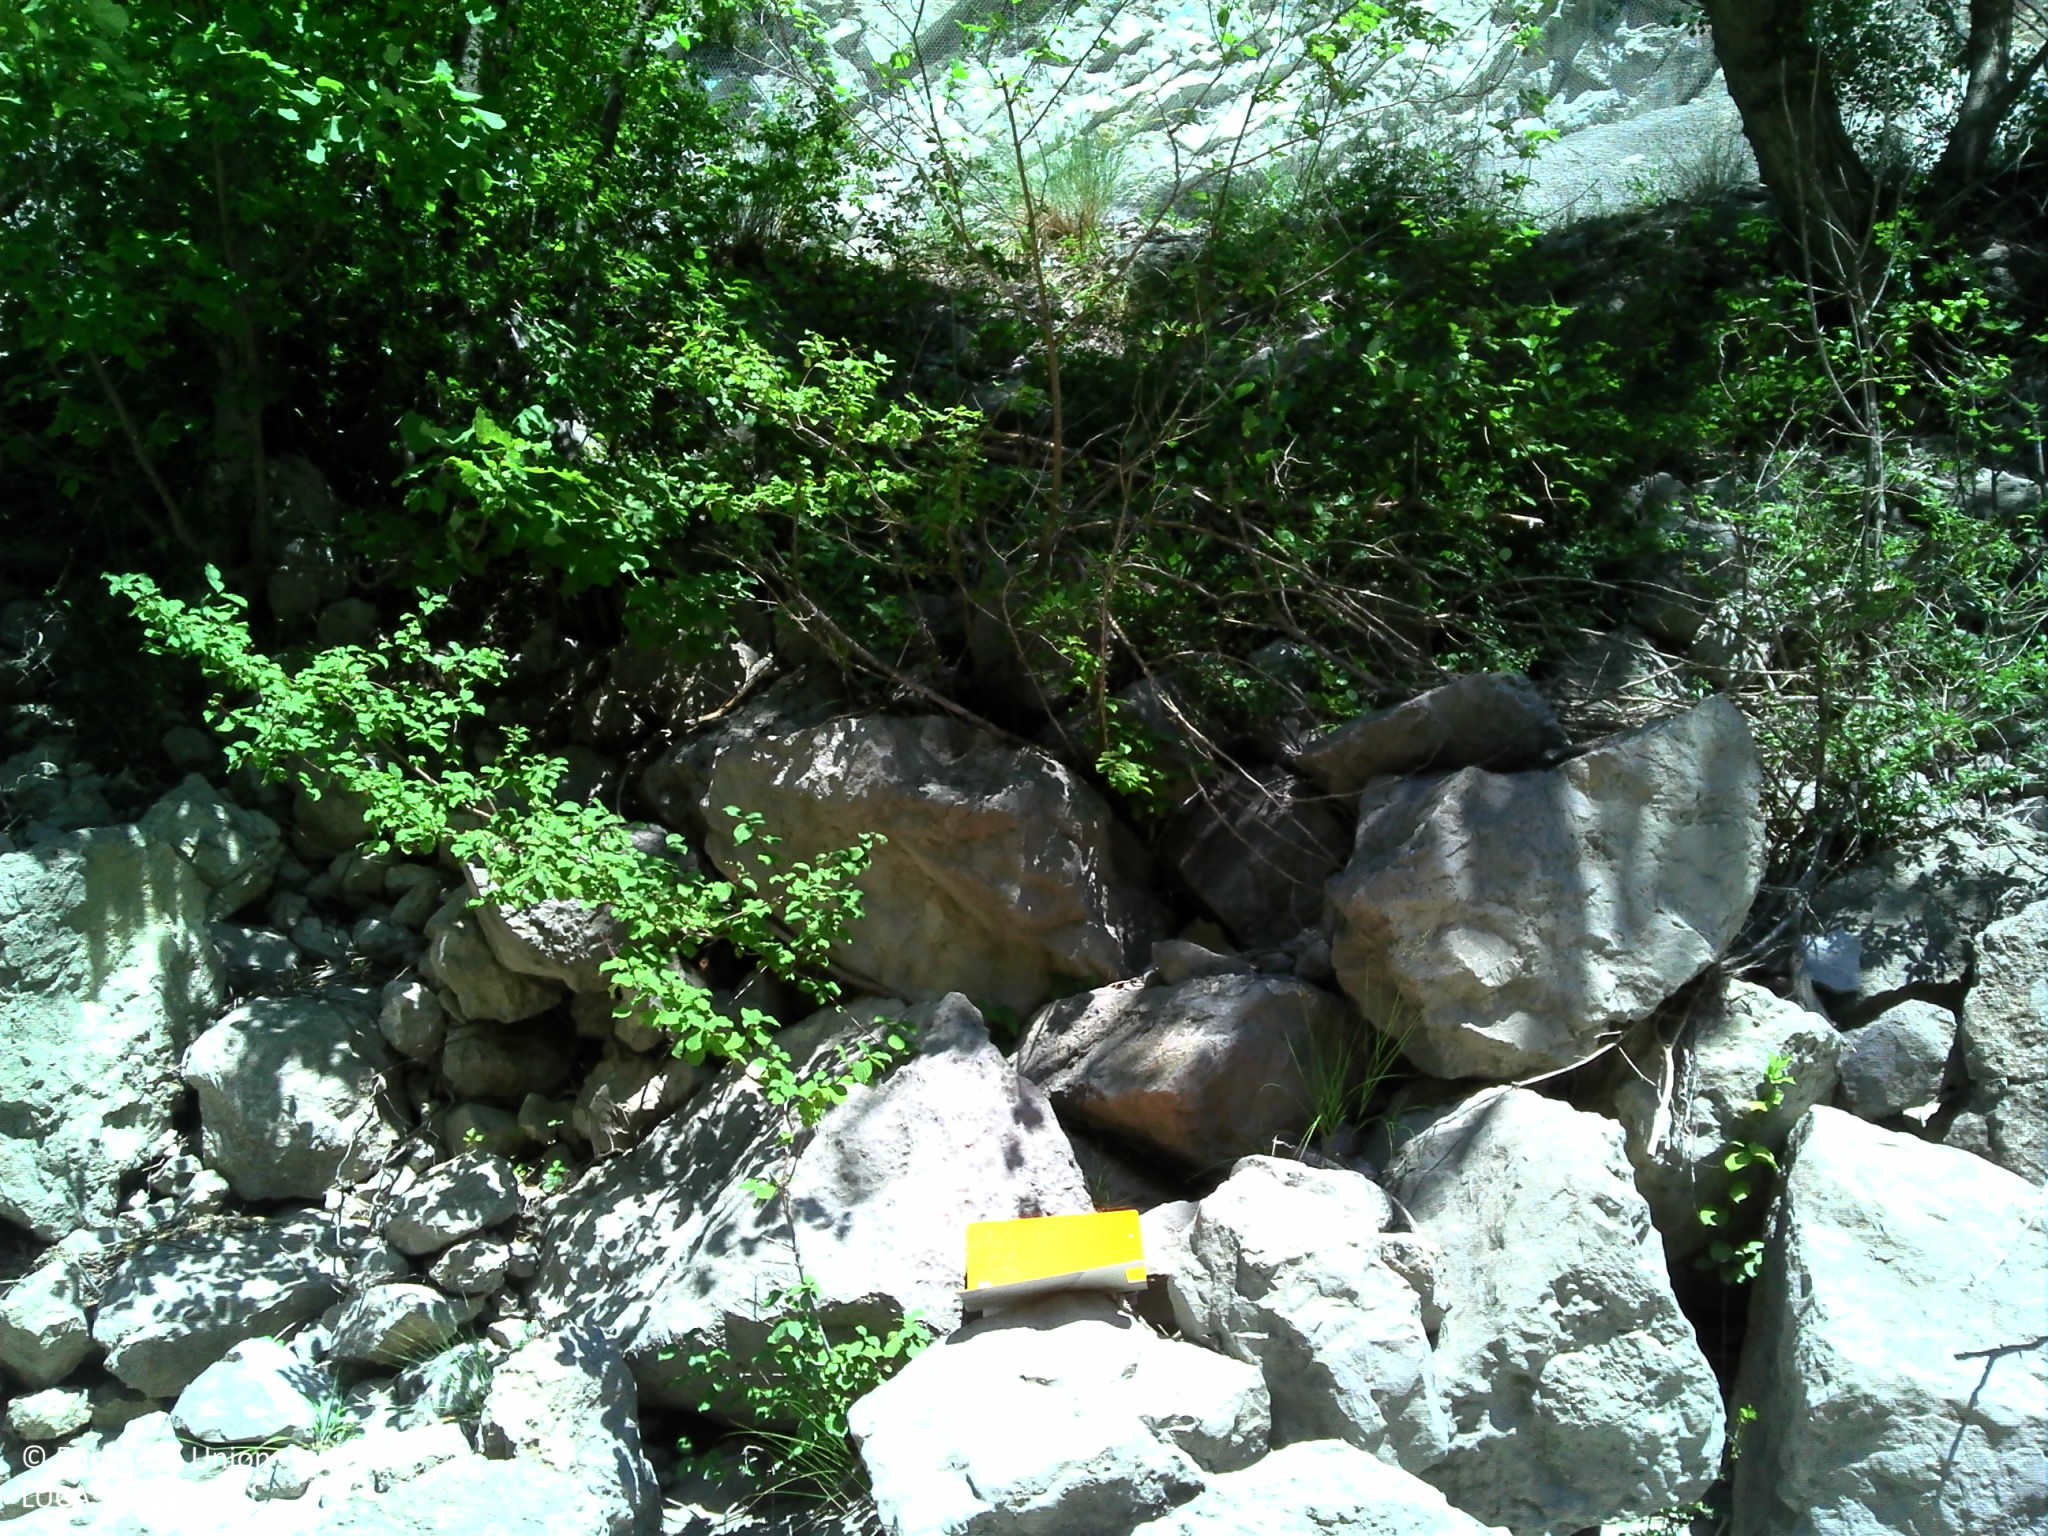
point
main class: Woodland
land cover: Broadleaved woodland
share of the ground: 50 - 75 %
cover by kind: unconsolidated bare surface 50 %, broadleaved forest trees 40 %, herbaceous plants 10 %
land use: Semi-natural and natural areas not in use
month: July
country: FR
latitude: 44.0121
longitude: 6.2532
